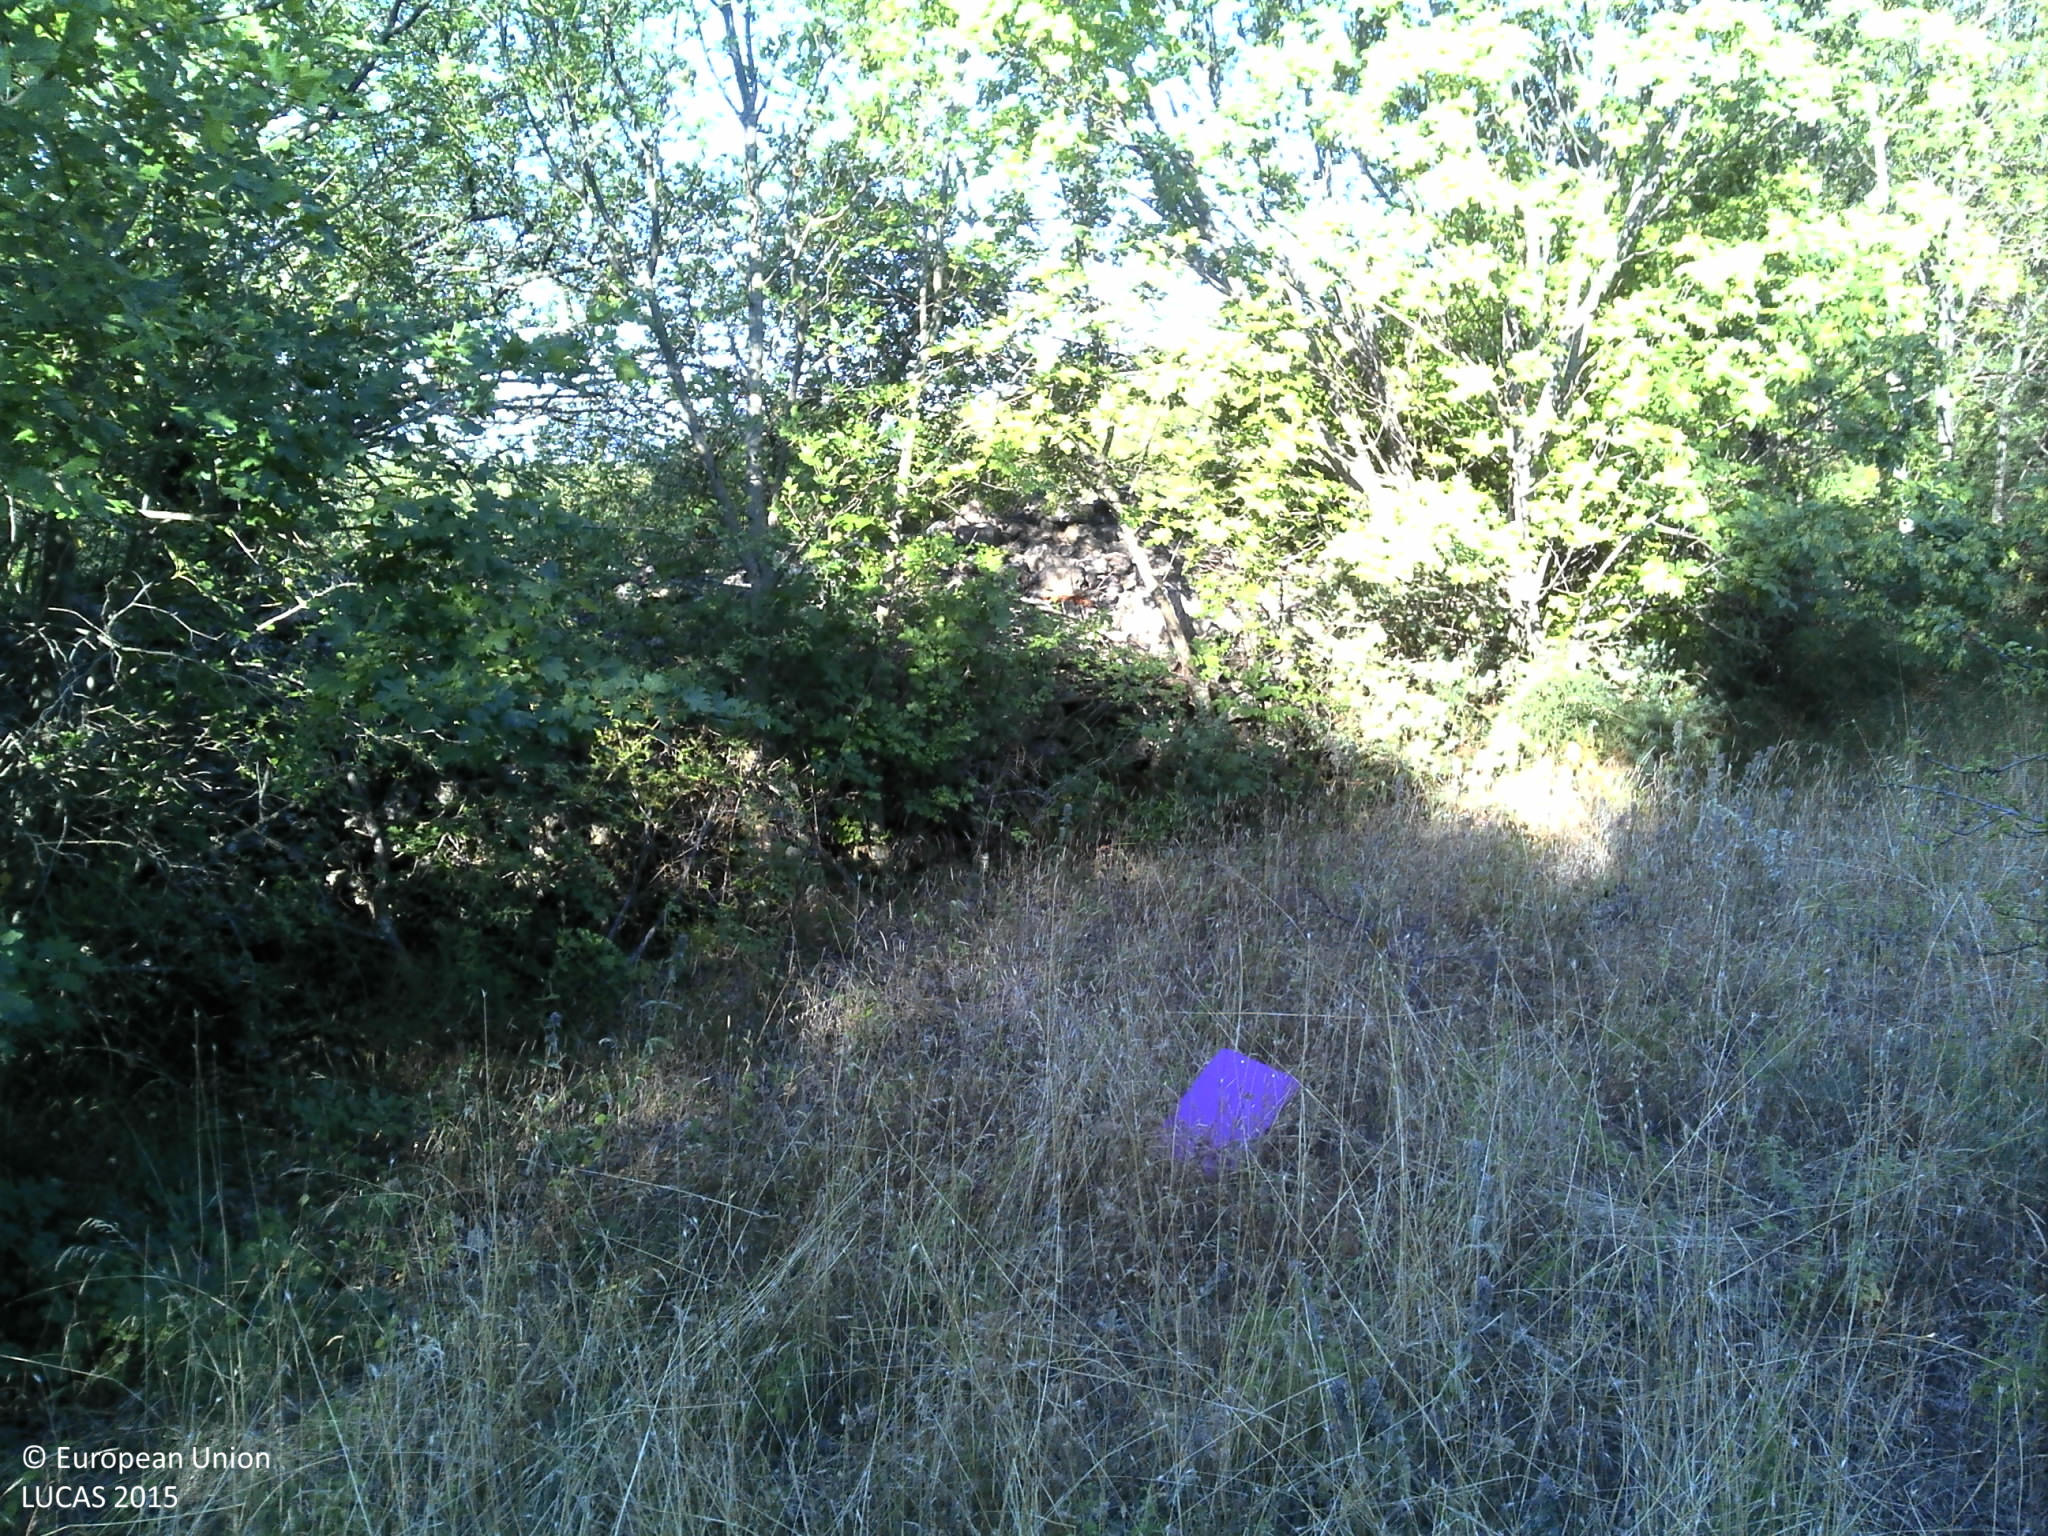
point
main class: Woodland
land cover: Broadleaved woodland
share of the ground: 25 - 50 %
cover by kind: broadleaved forest trees 40 %, shrubs 30 %, herbaceous plants 30 %
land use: Semi-natural and natural areas not in use
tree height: > 5 m
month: July
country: HR
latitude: 44.0807
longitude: 16.0991
